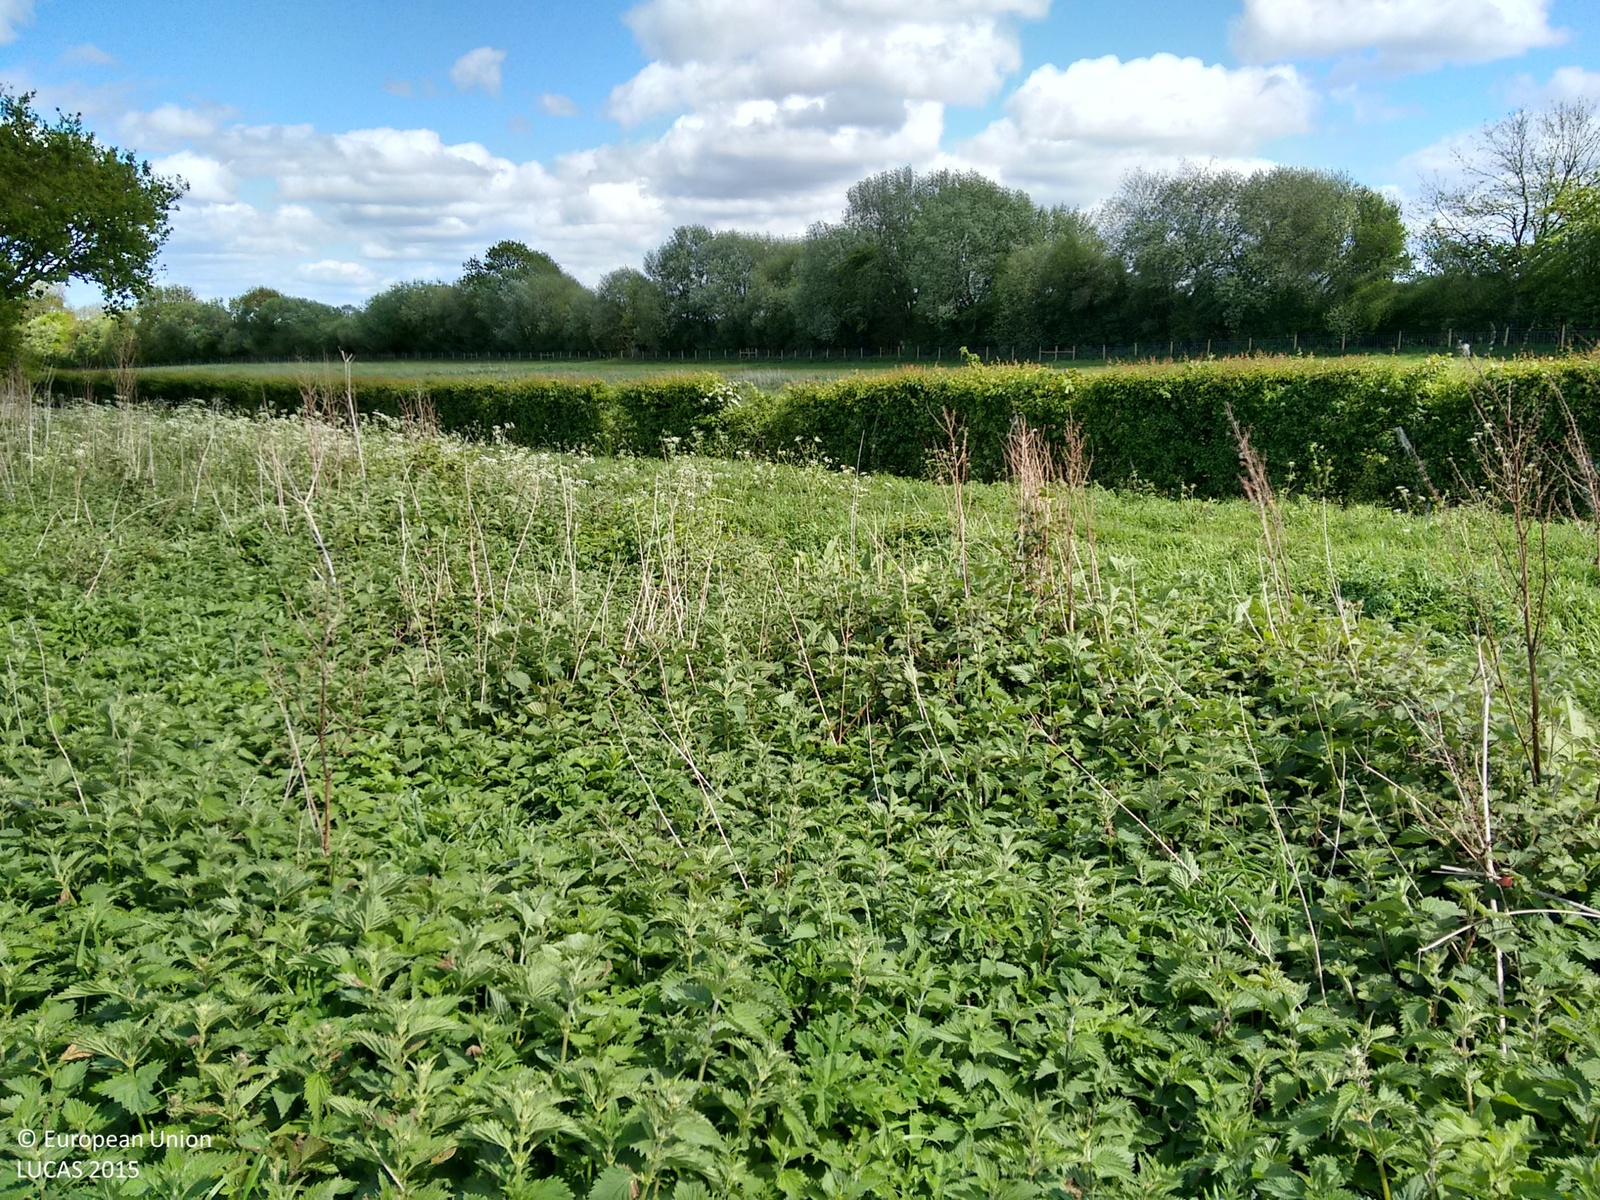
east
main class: Cropland
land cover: Common wheat
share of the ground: > 75 %
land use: Agriculture (excluding fallow land and kitchen gardens)
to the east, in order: Common wheat; Spontaneously vegetated surfaces; Managed hedges; Ditches and canals; Fences; Grassland without tree/shrub cover; Fences; Abandoned hedges; Common wheat
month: May
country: GB
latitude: 51.3194
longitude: -1.1960
